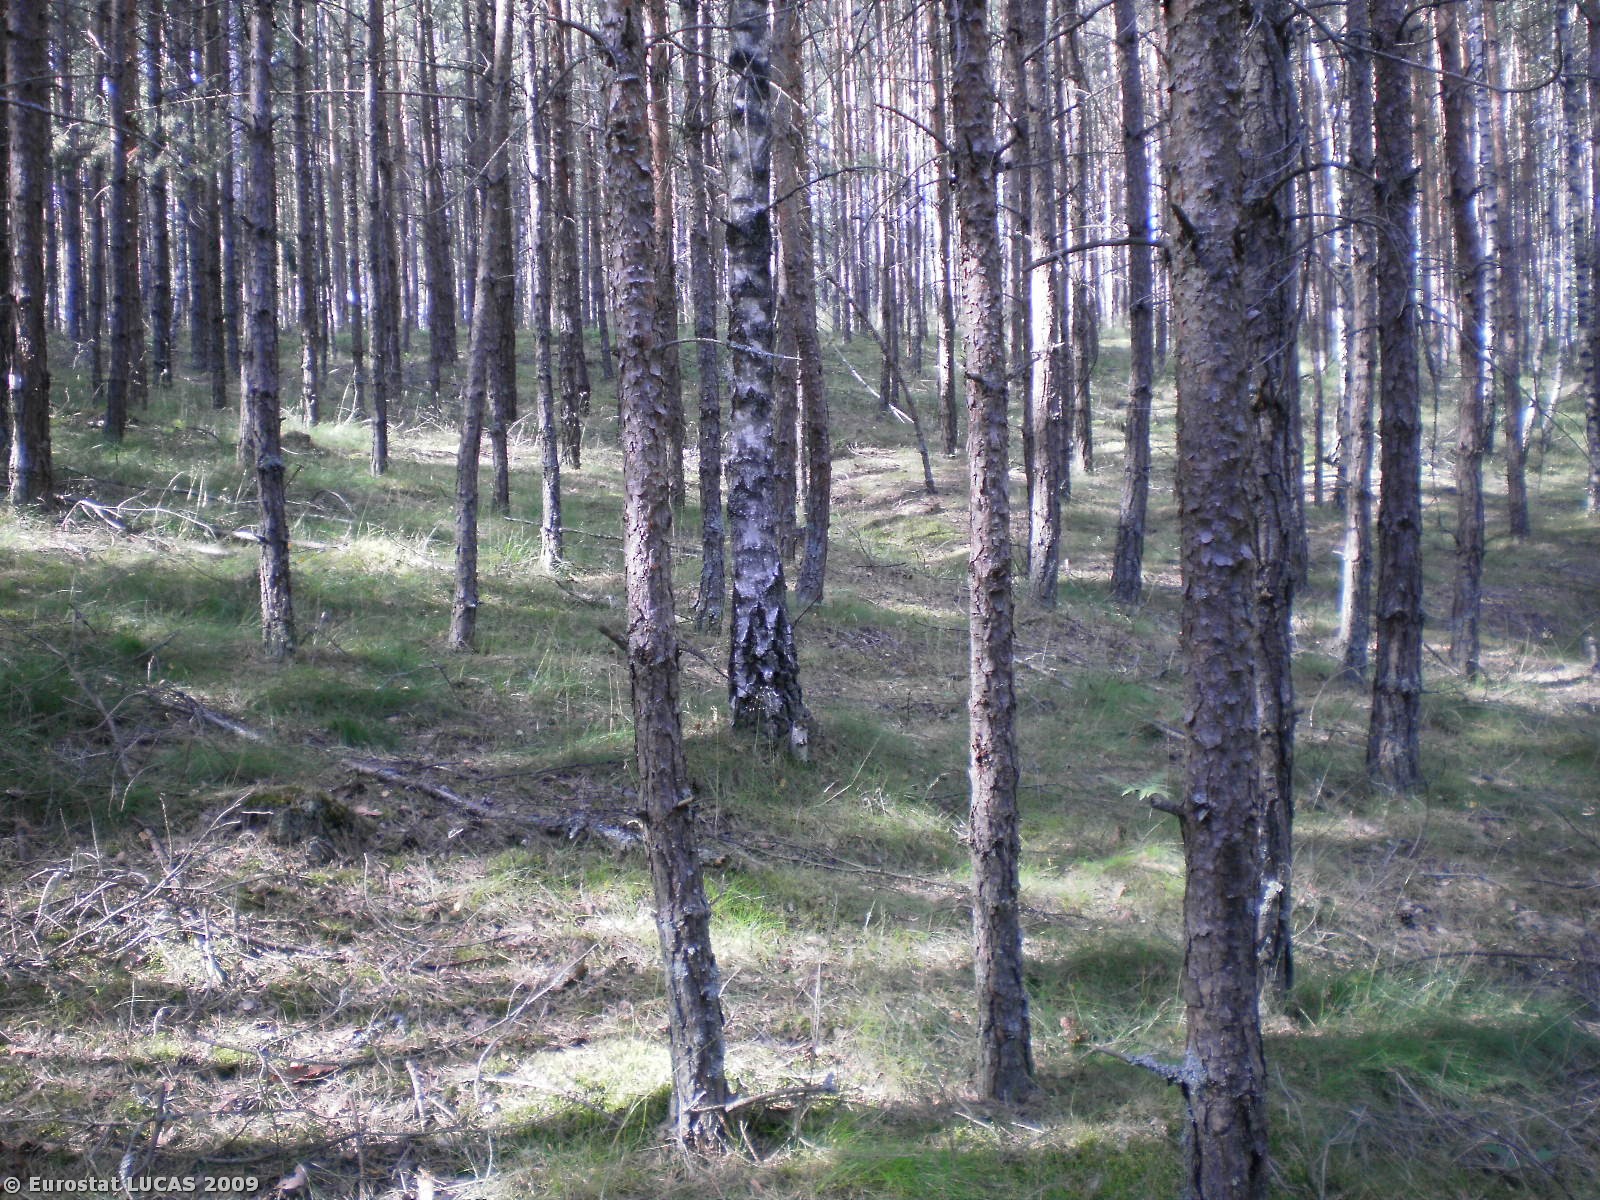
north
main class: Woodland
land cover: Coniferous woodland
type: hemiboreal forest and nemoral coniferous forest and mixed broadleaved-coniferous forest
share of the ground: > 75 %
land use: Forestry
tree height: > 5 m
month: July
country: PL
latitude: 54.0362
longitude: 17.7846
